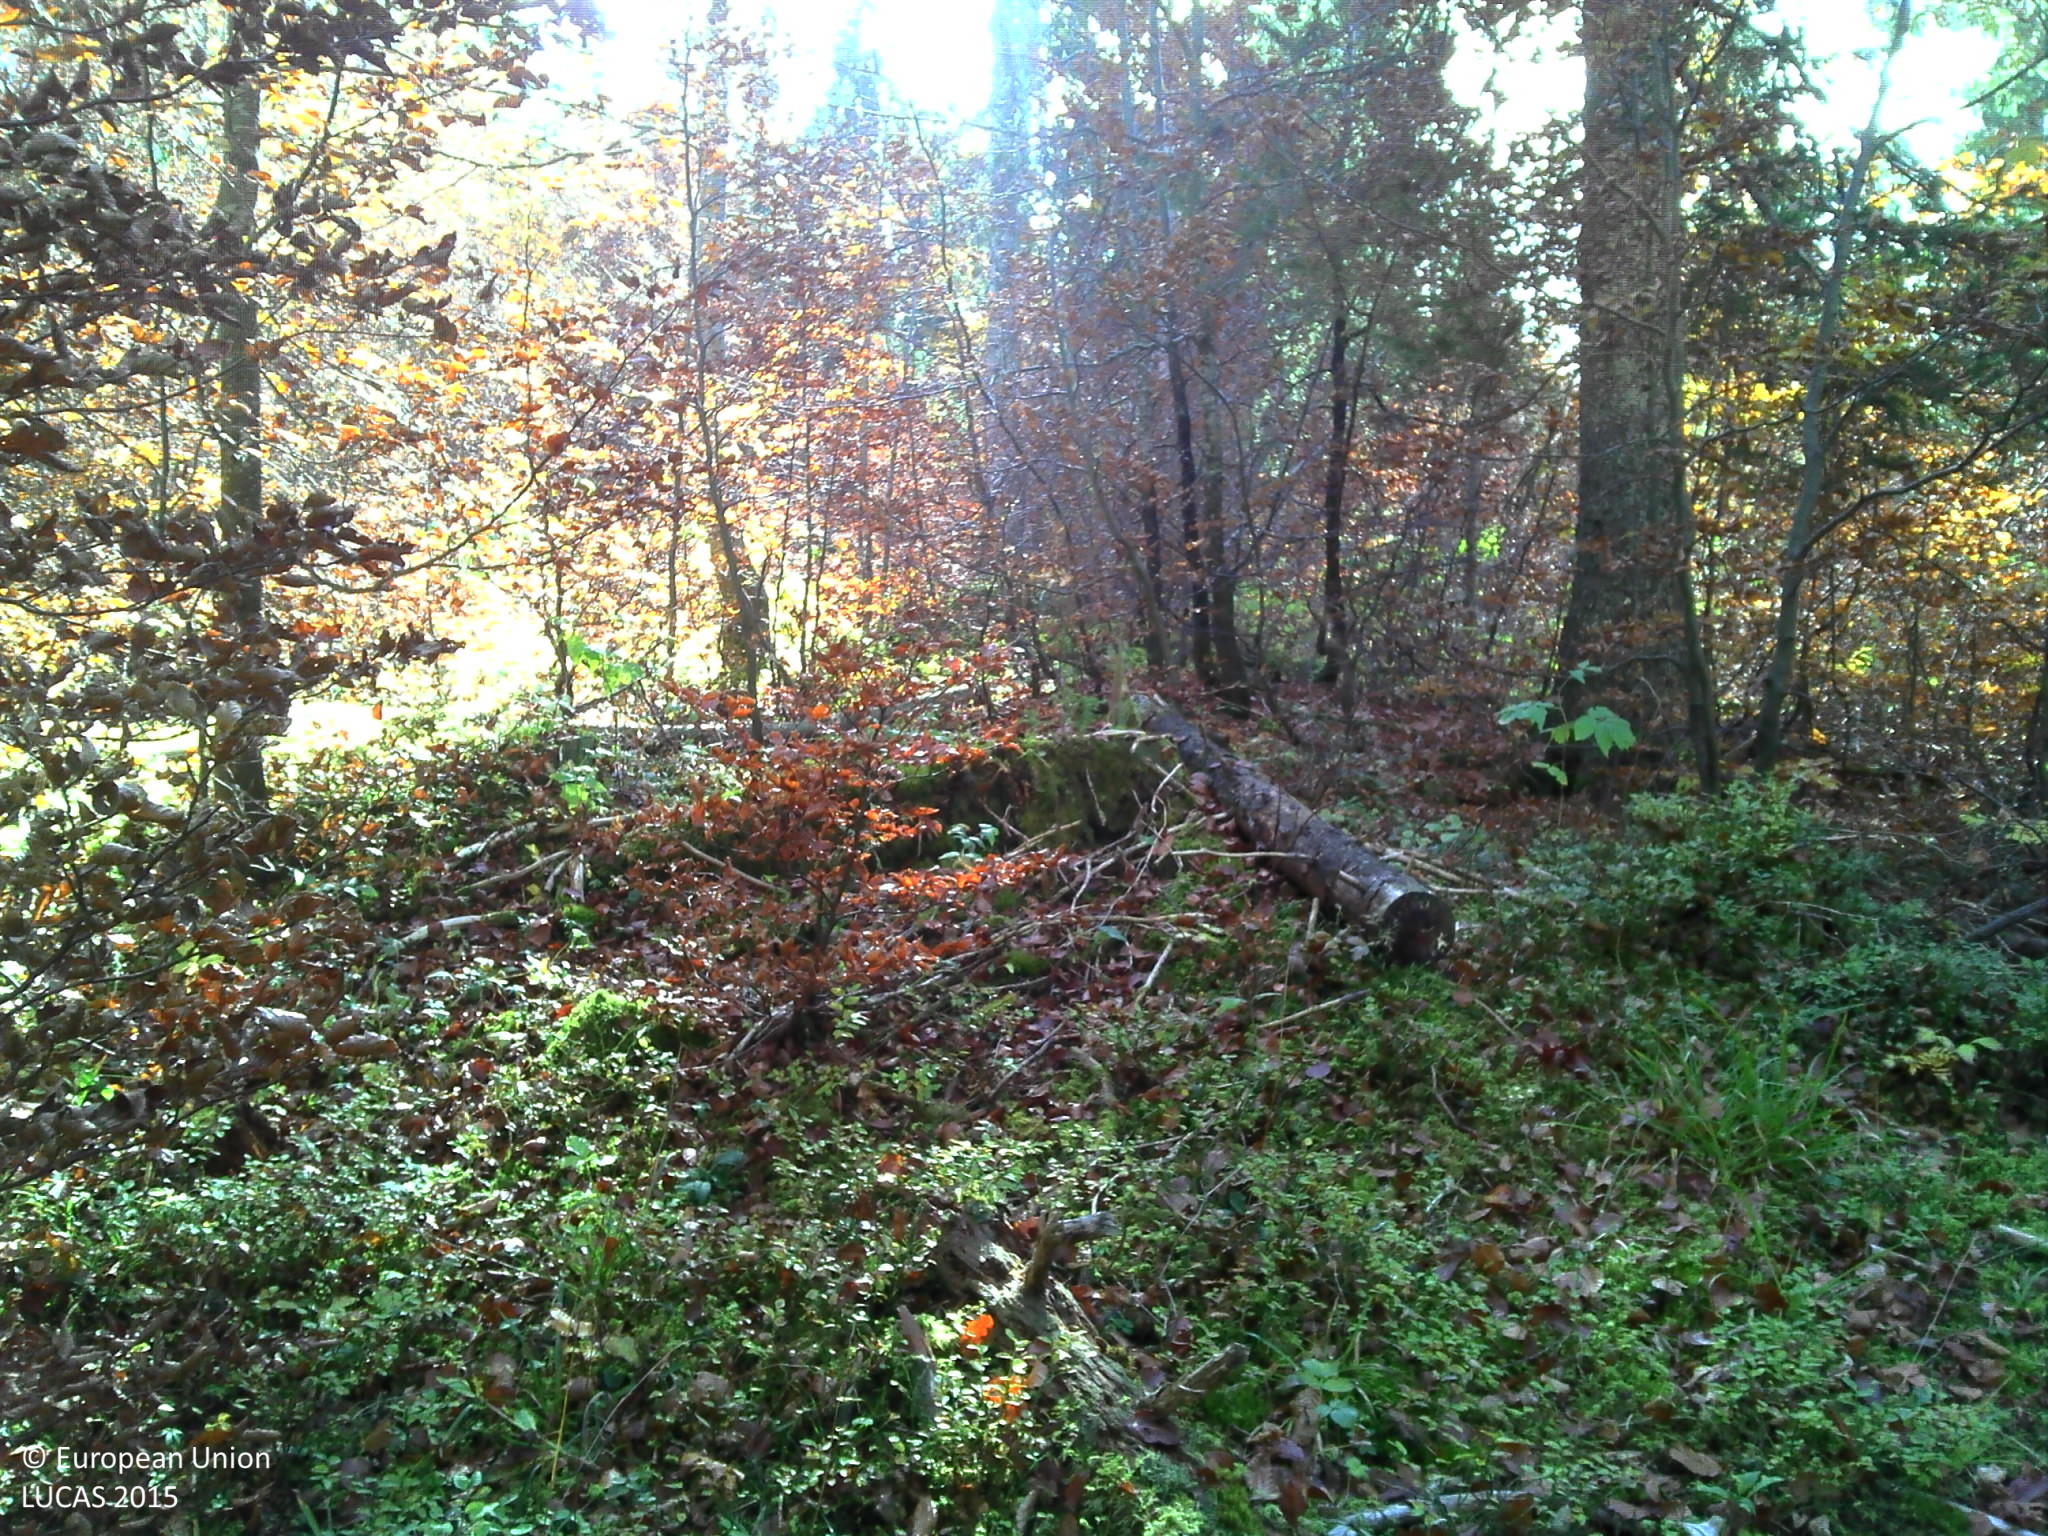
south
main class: Woodland
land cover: Spruce dominated mixed woodland
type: mountainous beech forest
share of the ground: > 75 %
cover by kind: broadleaved forest trees 40 %, coniferous forest trees 30 %, herbaceous plants 10 %, lichens and mosses 10 %, consolidated bare surface 5 %, unconsolidated bare surface 5 %
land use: Forestry
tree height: > 5 m
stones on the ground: 10 - 25 %
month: October
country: FR
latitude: 46.6245
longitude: 6.1501
